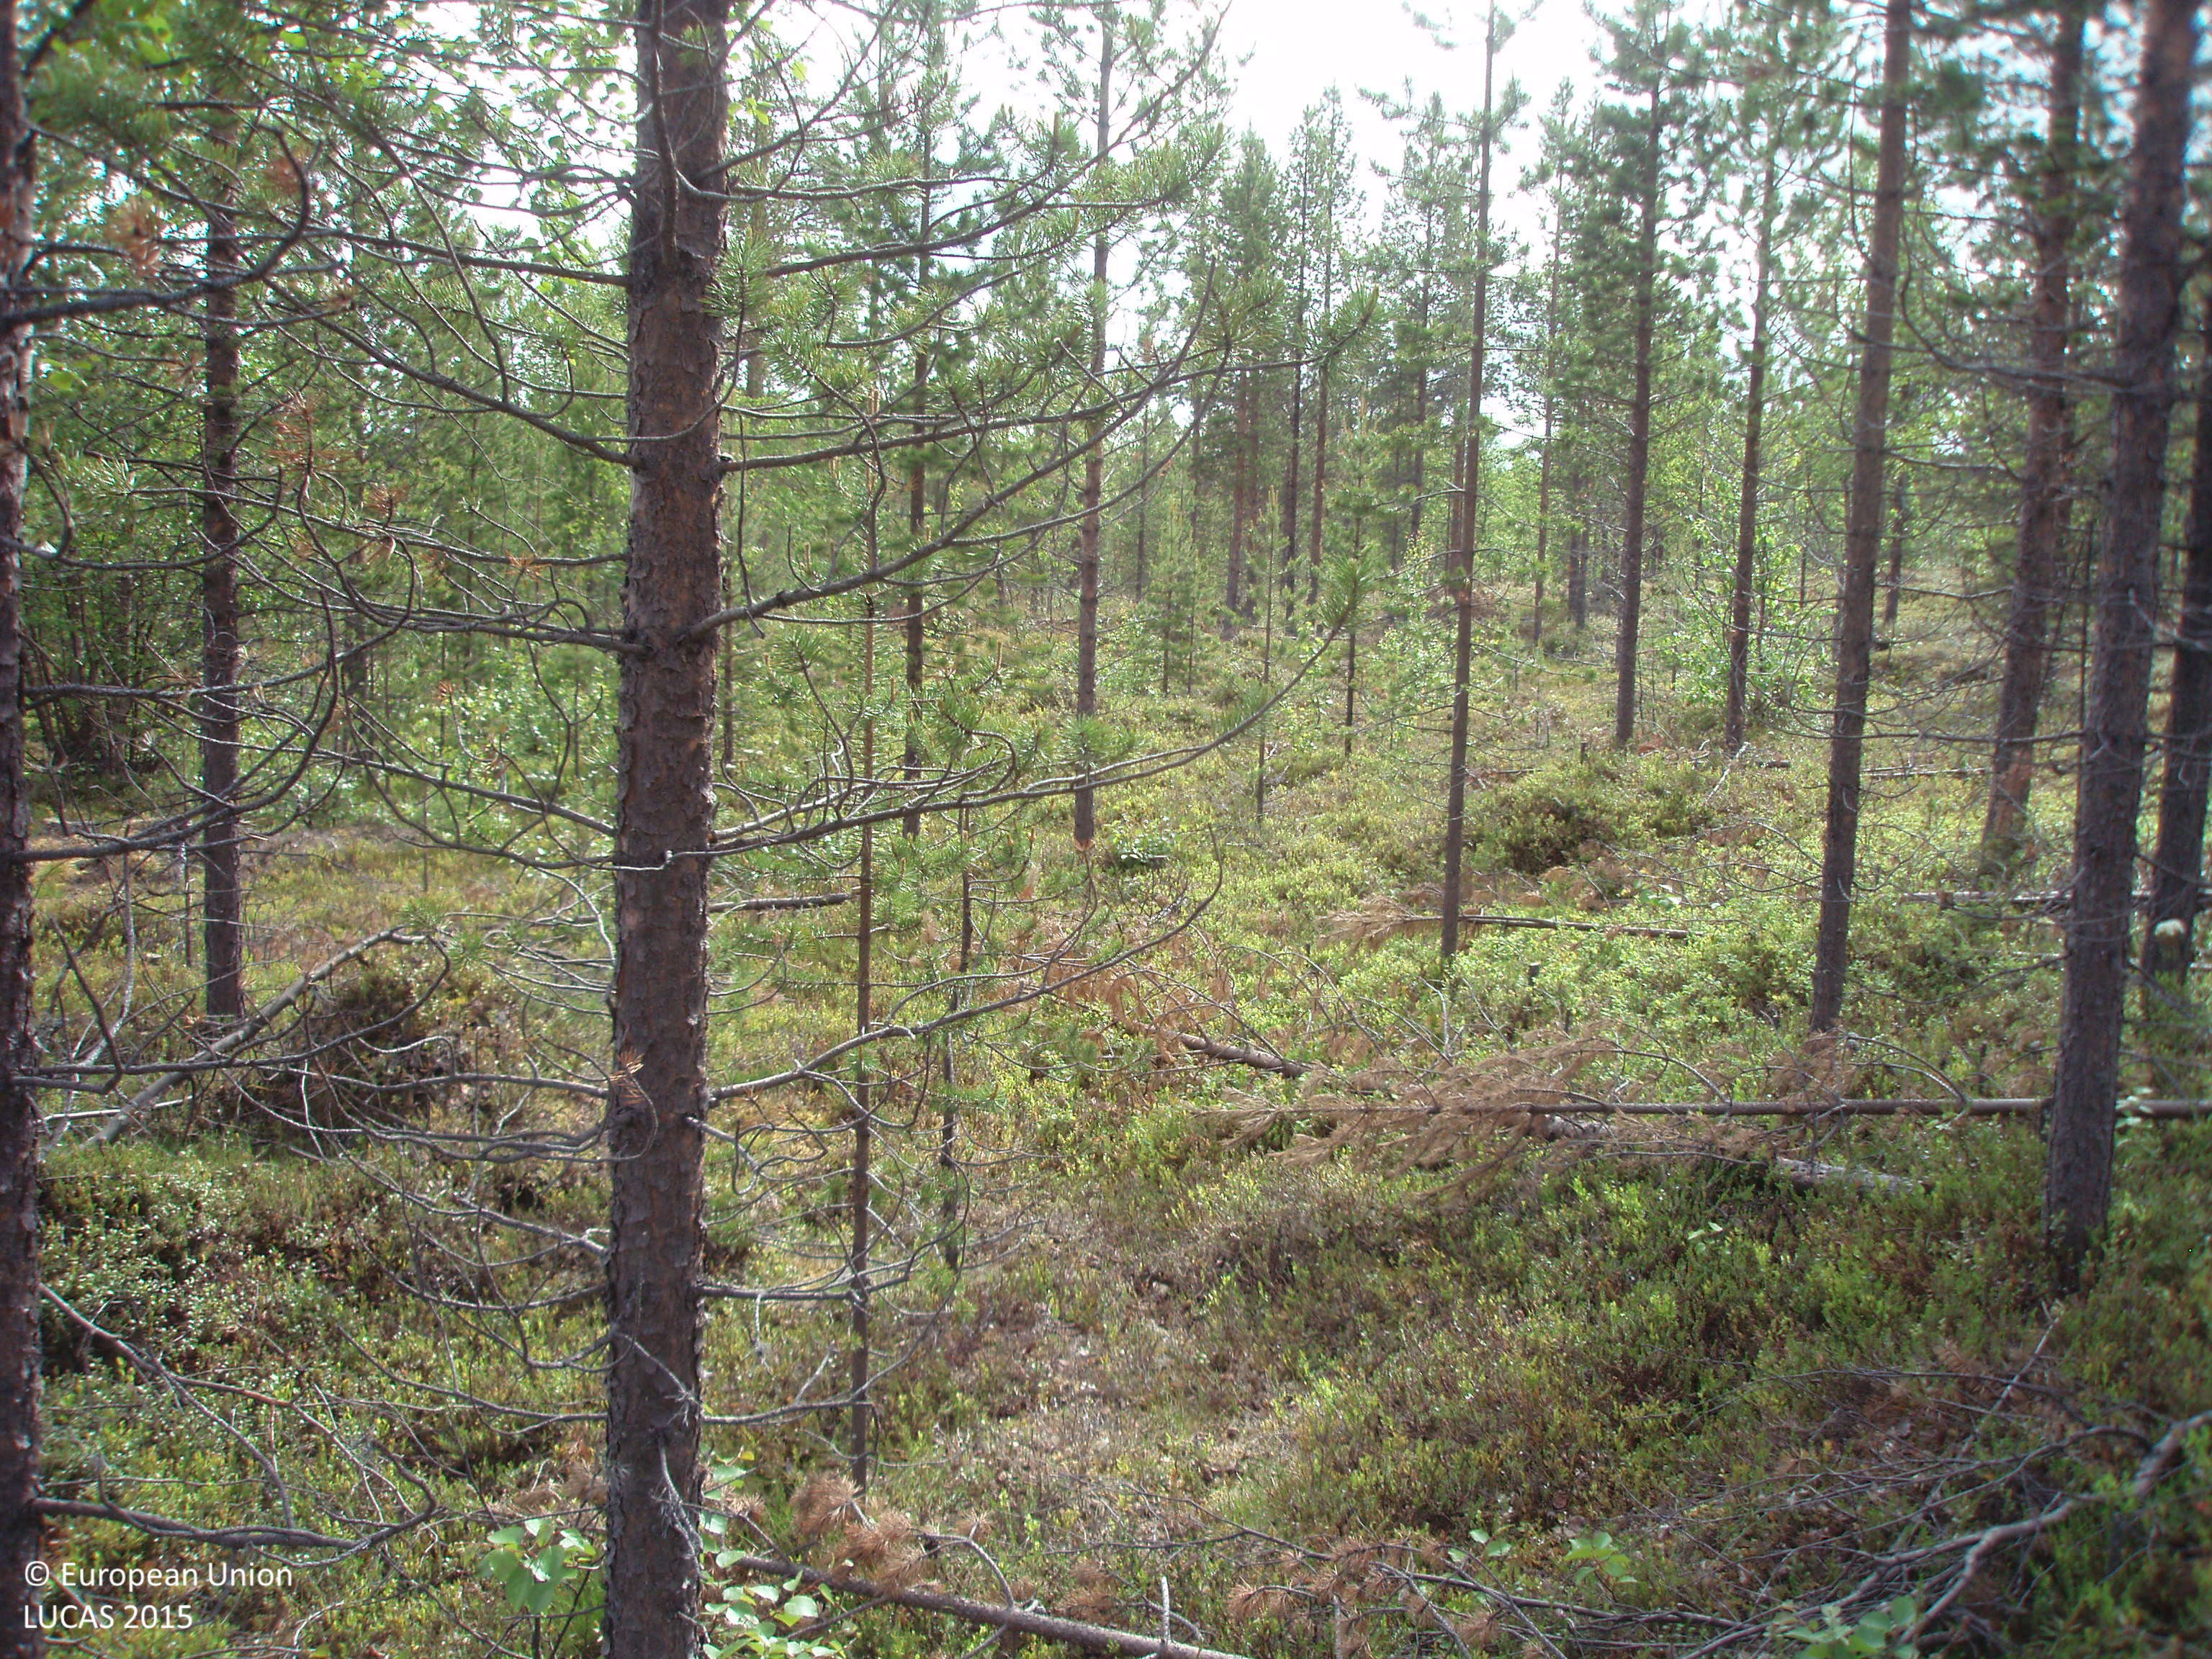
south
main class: Woodland
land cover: Pine dominated mixed woodland
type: boreal forest
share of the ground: 50 - 75 %
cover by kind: coniferous forest trees 40 %, shrubs 40 %, broadleaved forest trees 20 %
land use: Forestry
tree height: > 5 m
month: July
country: FI
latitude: 69.0719
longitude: 27.2978
